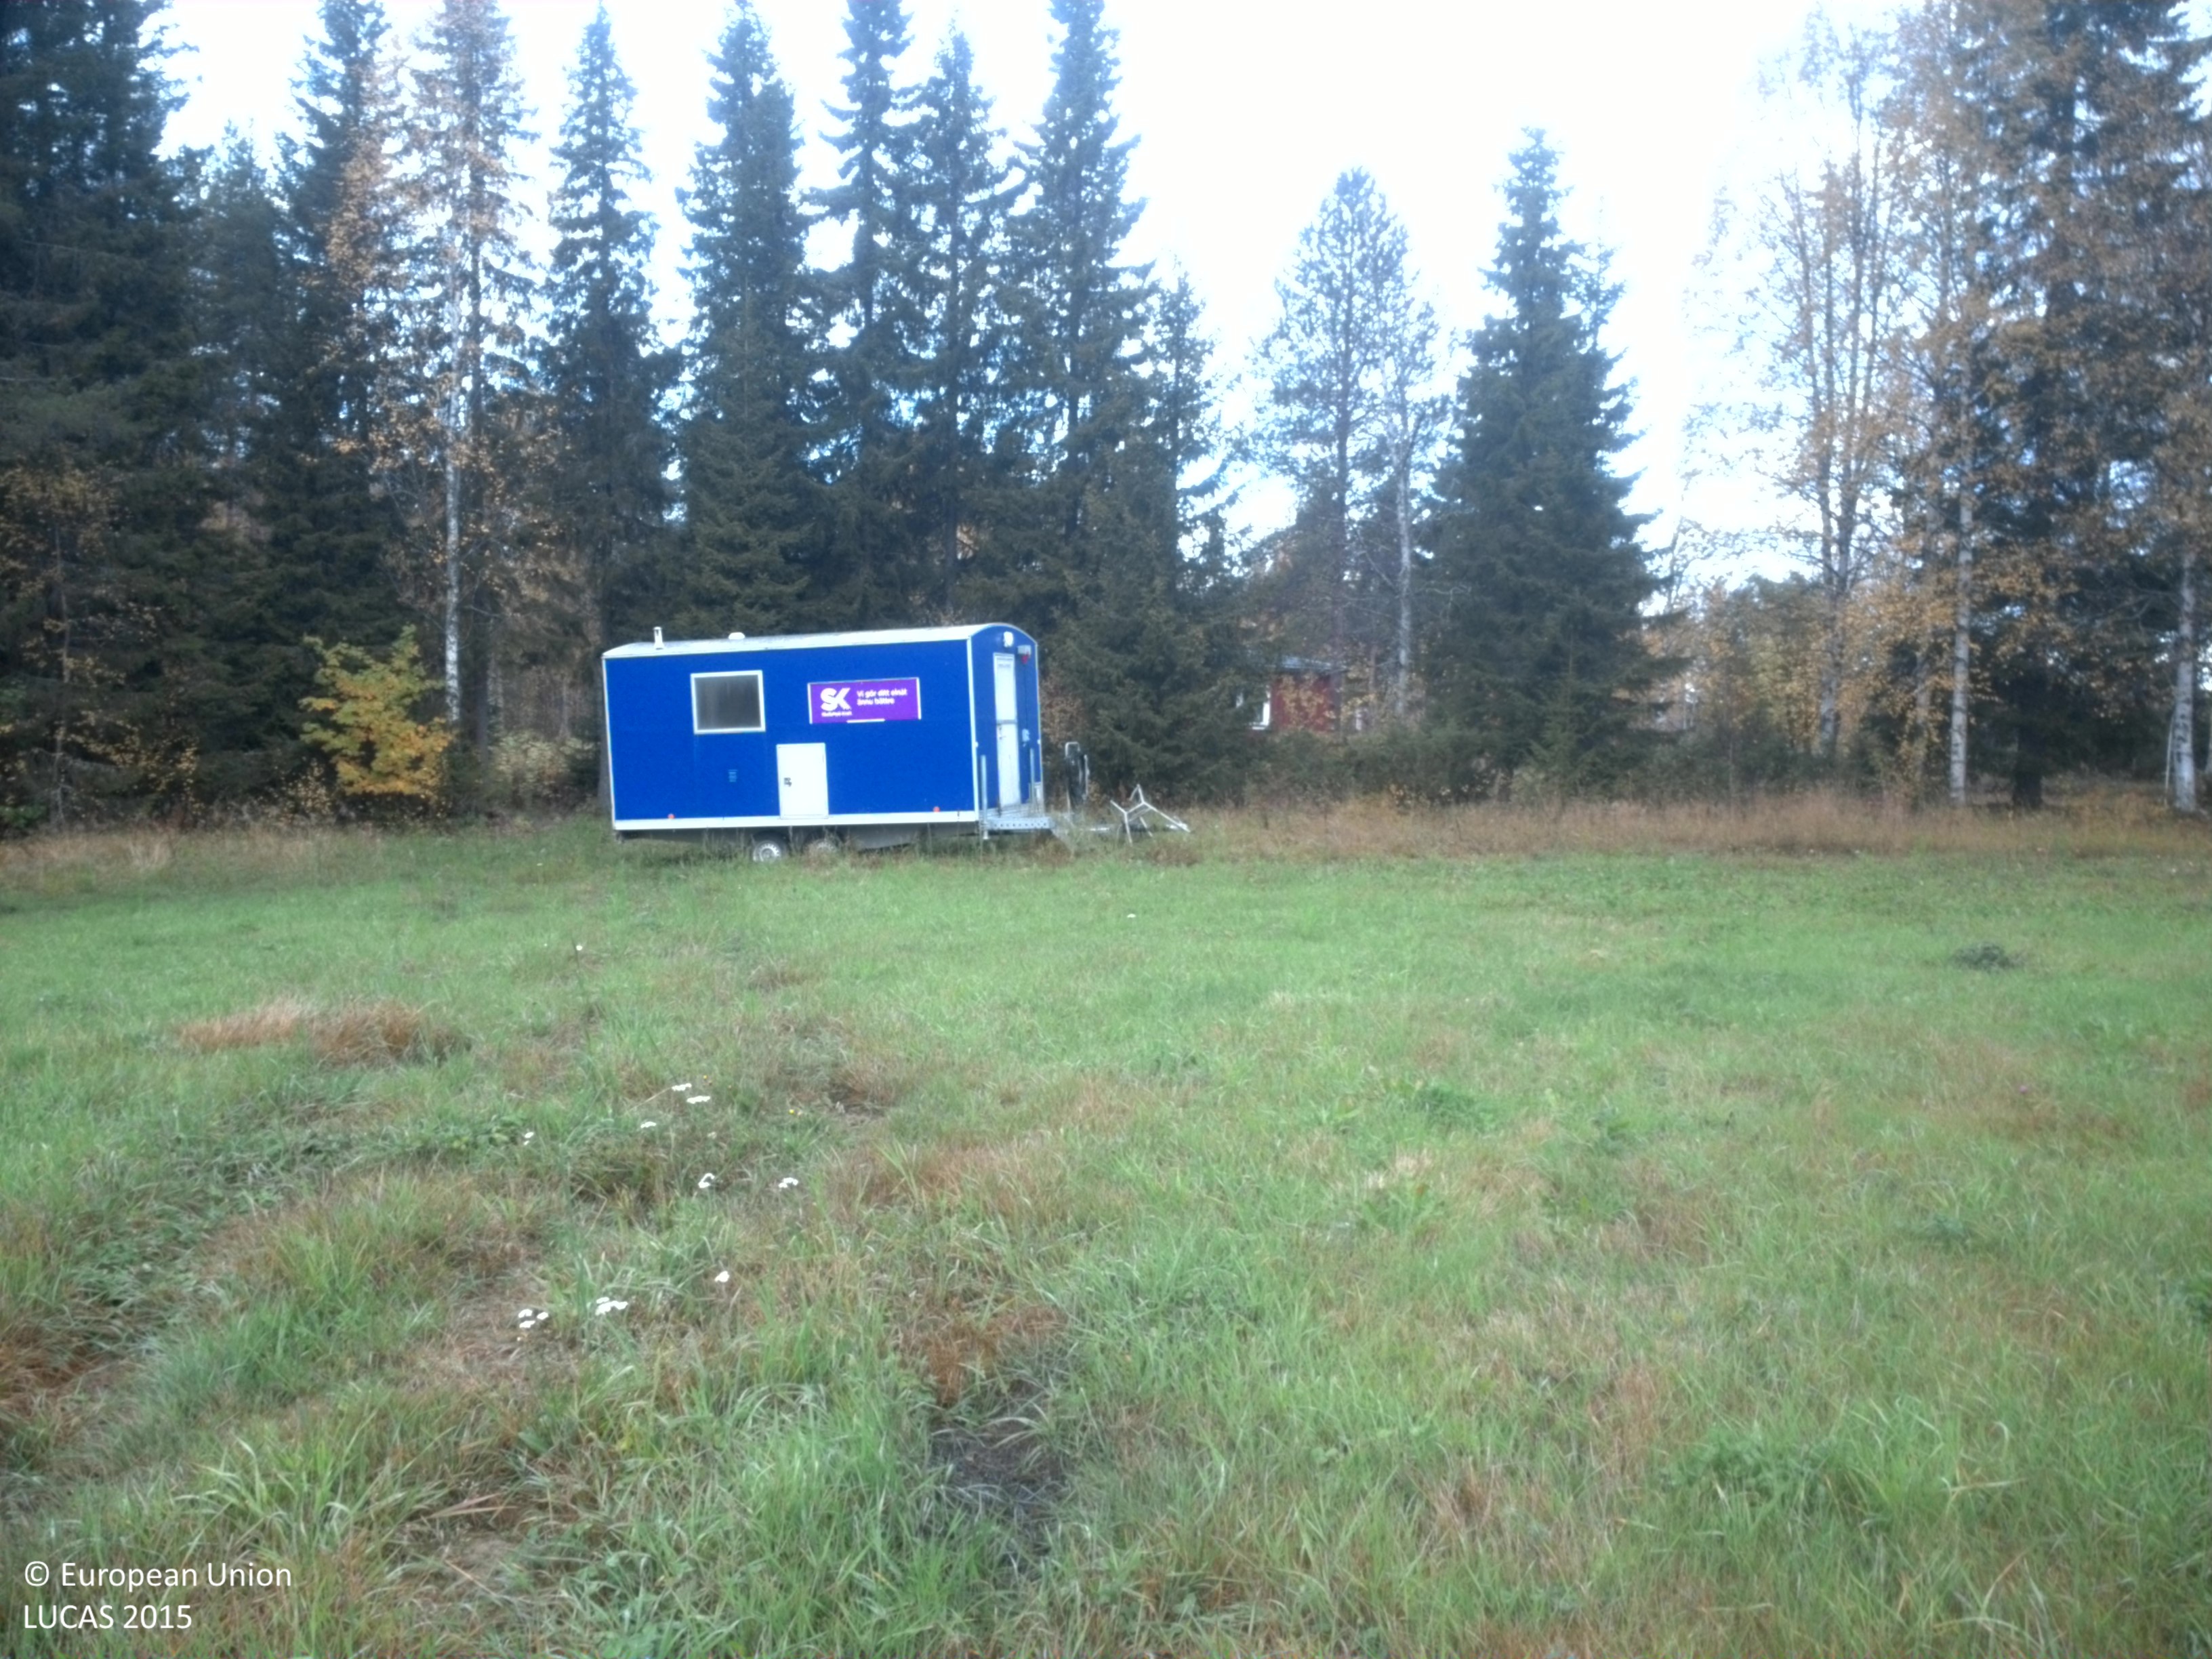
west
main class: Grassland
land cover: Grassland without tree/shrub cover
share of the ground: > 75 %
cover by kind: herbaceous plants 100 %
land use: Agriculture (excluding fallow land and kitchen gardens)
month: September
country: SE
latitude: 64.2293
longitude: 19.9746
